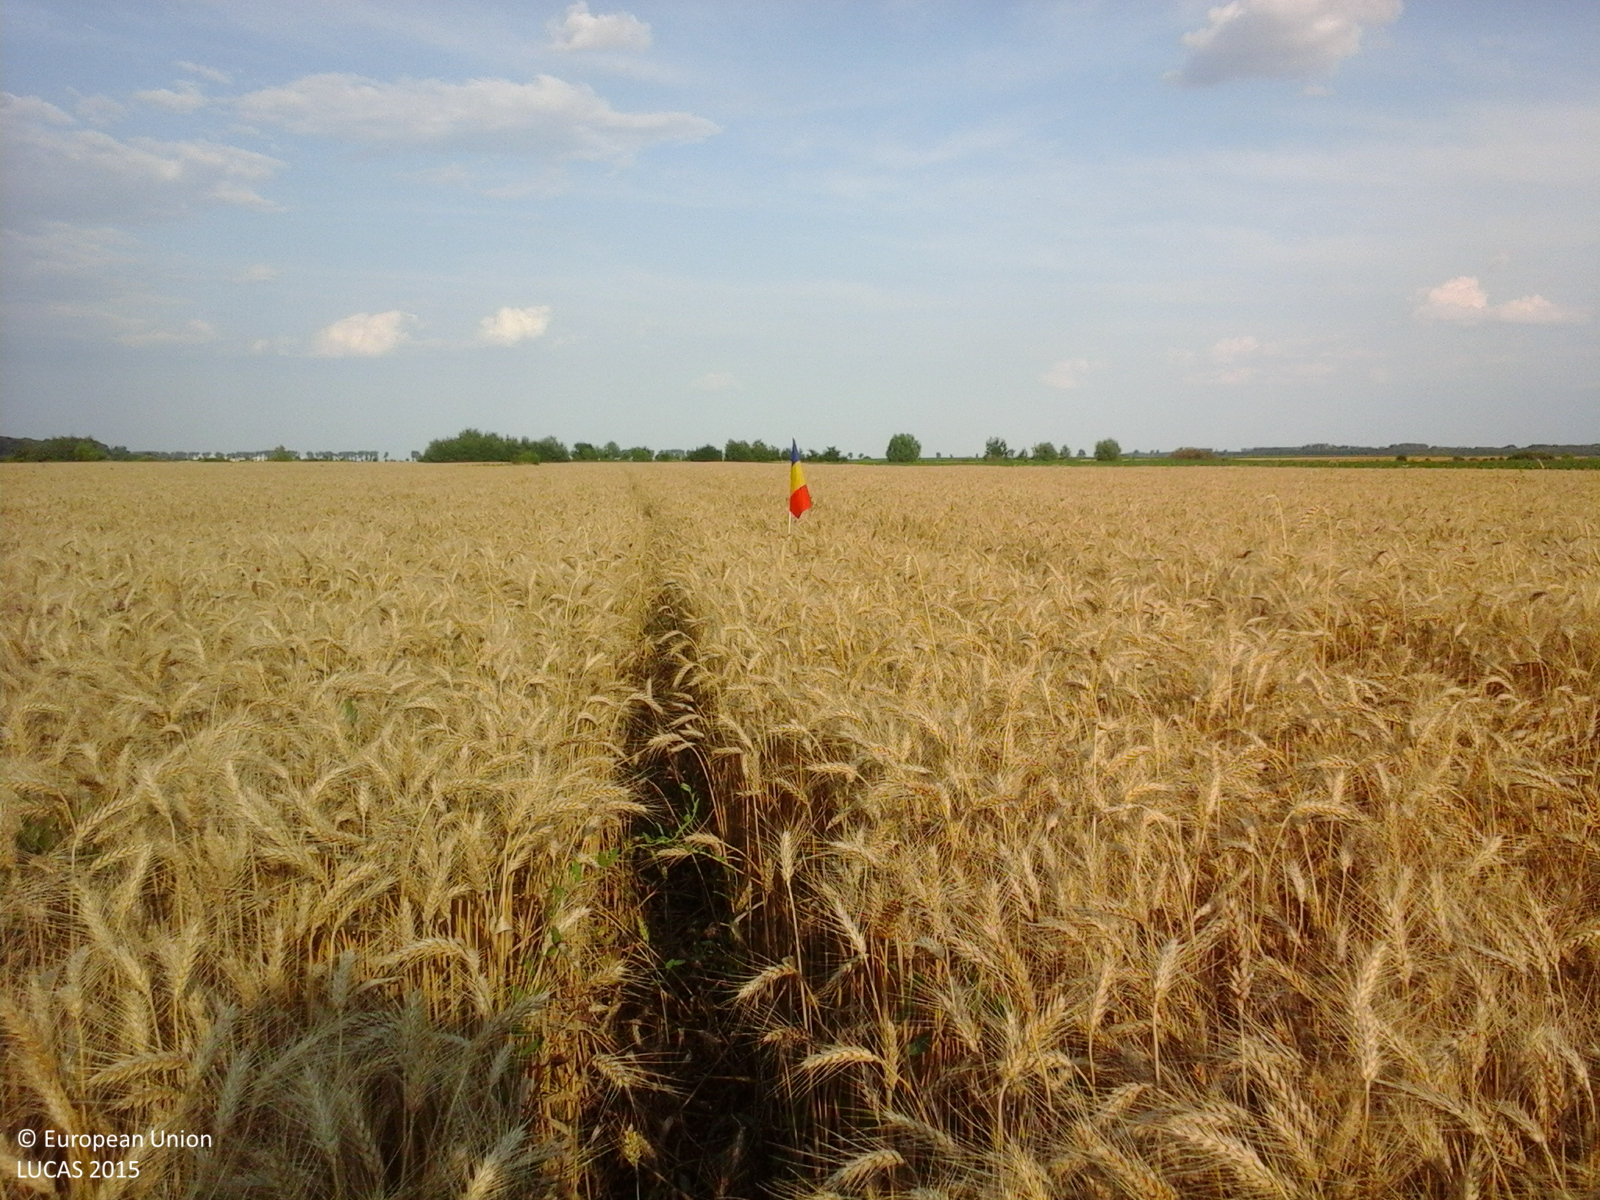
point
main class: Cropland
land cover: Common wheat
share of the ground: > 75 %
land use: Agriculture (excluding fallow land and kitchen gardens)
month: June
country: RO
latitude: 44.5671
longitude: 26.2394
